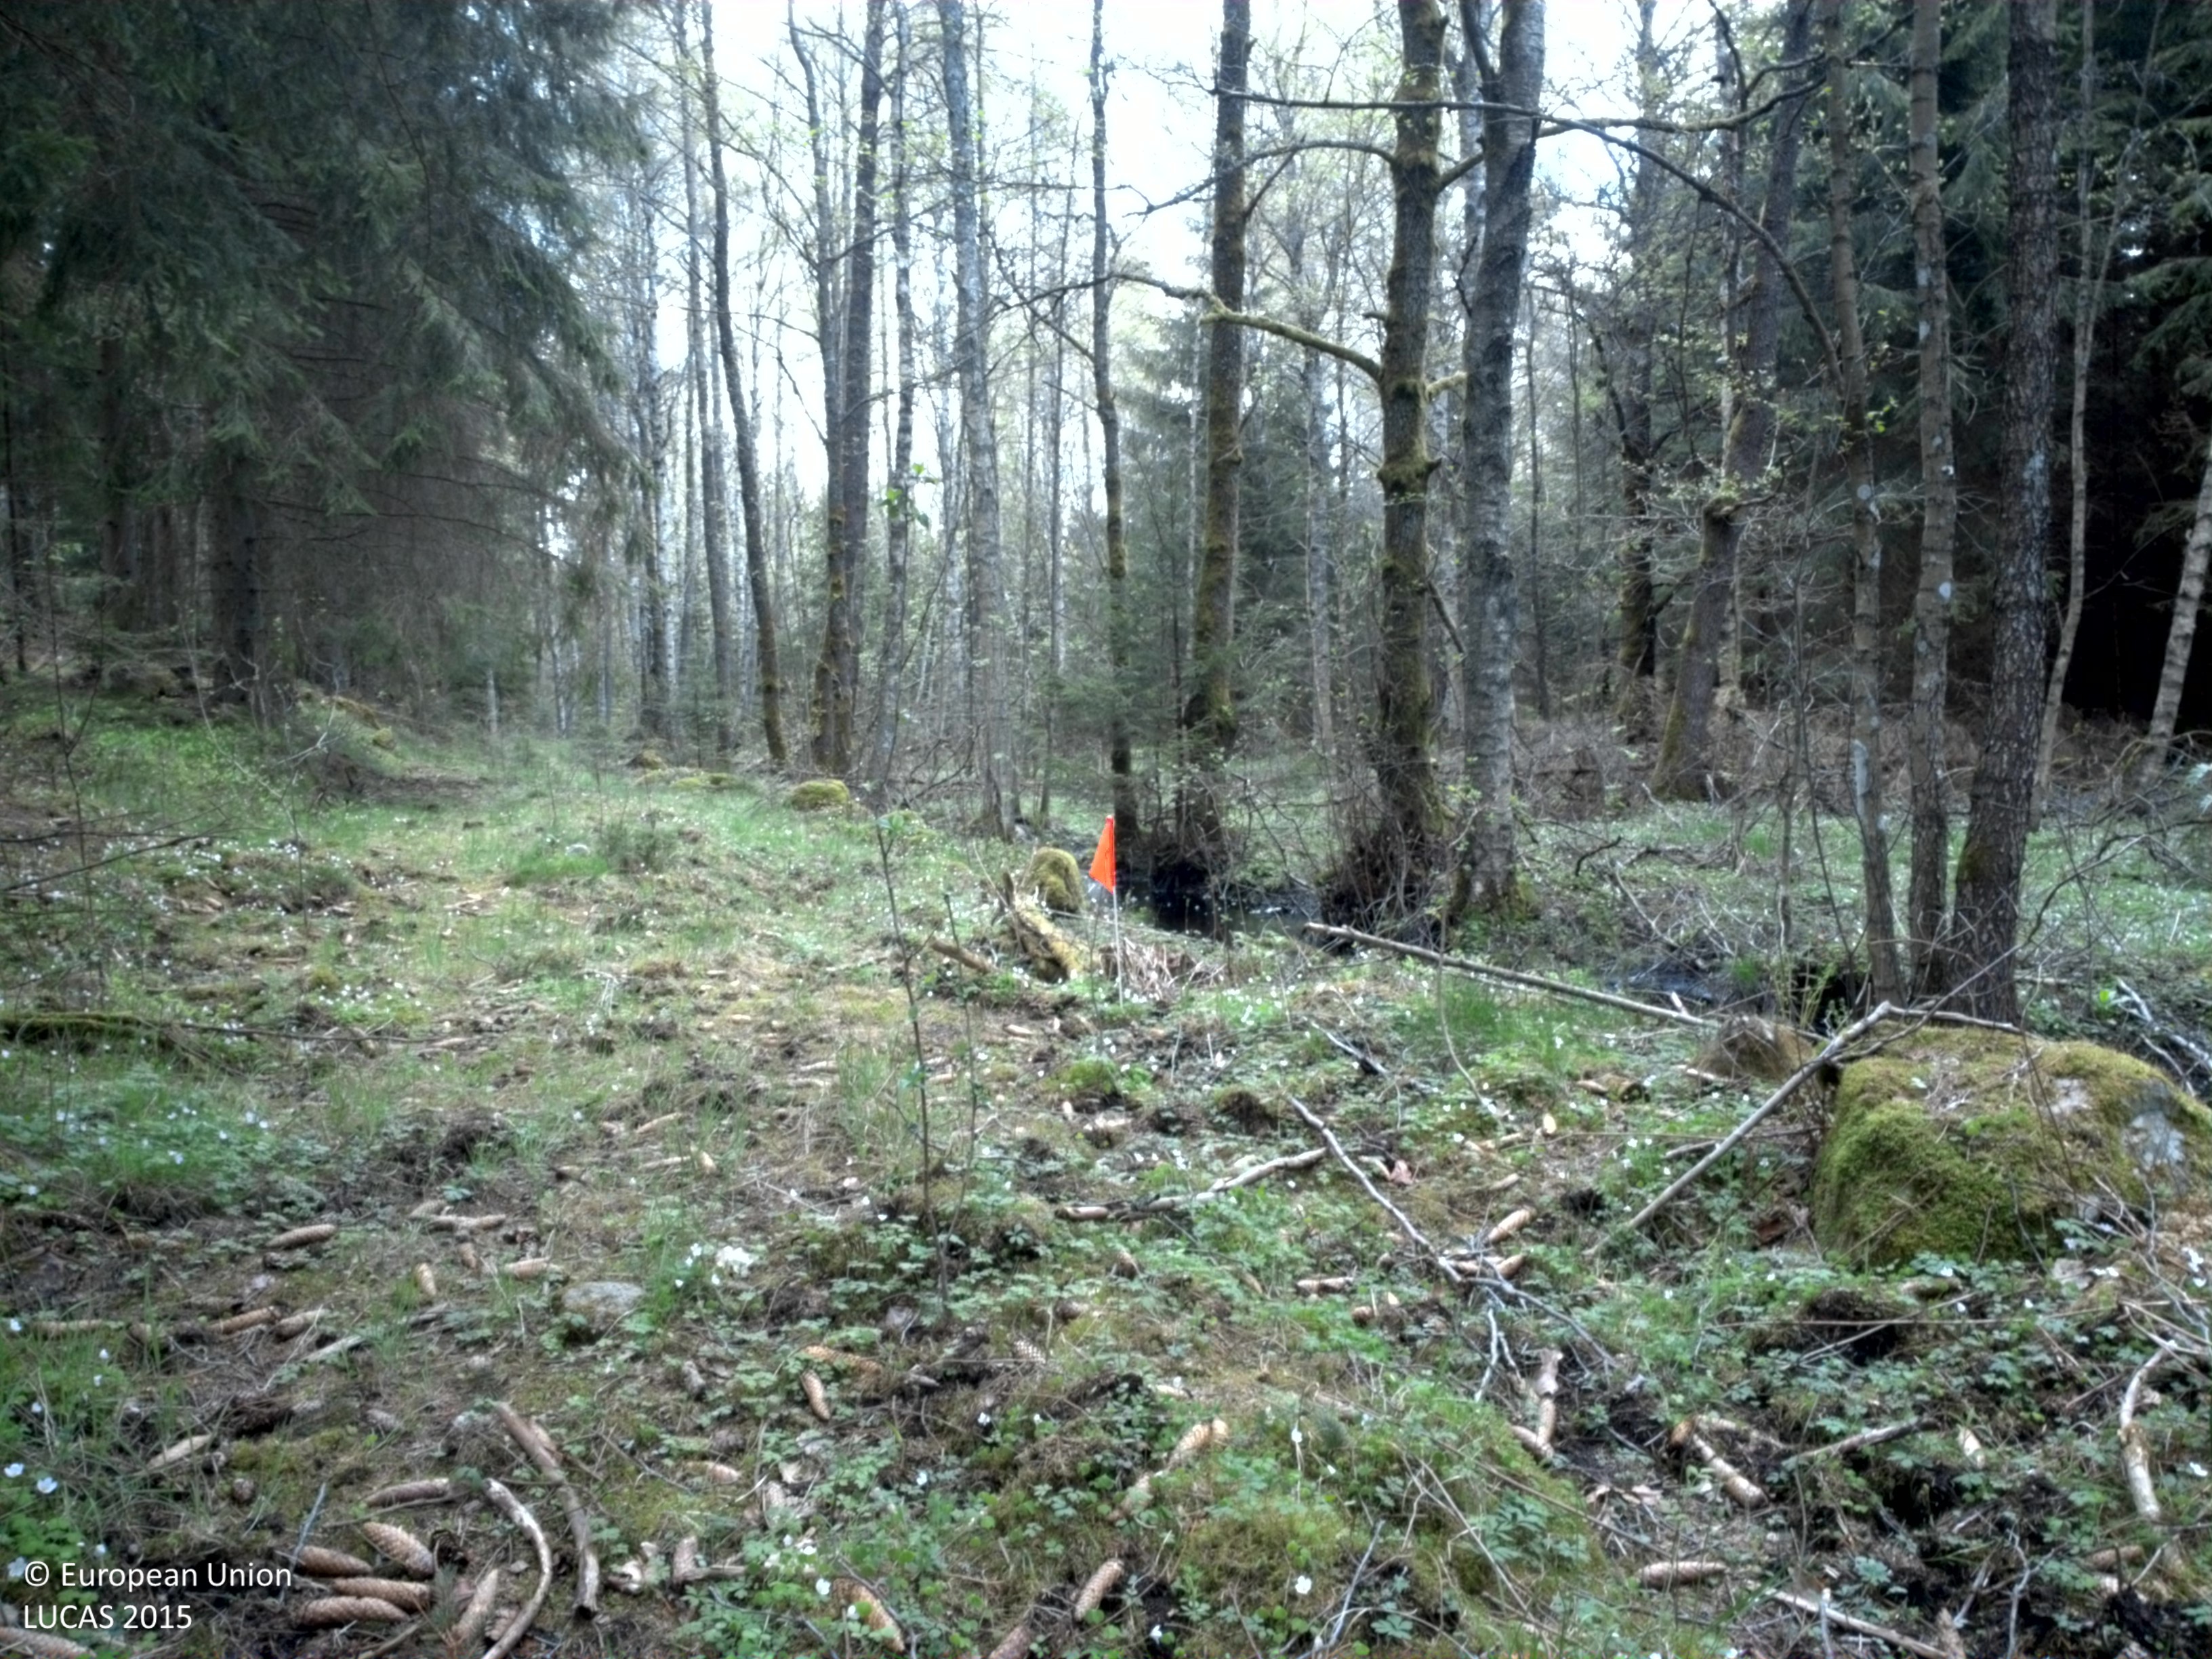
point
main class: Woodland
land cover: Spruce dominated mixed woodland
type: boreal forest
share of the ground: > 75 %
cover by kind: coniferous forest trees 75 %, broadleaved forest trees 25 %
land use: Forestry
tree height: > 5 m
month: May
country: SE
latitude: 56.4400
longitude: 15.2701
